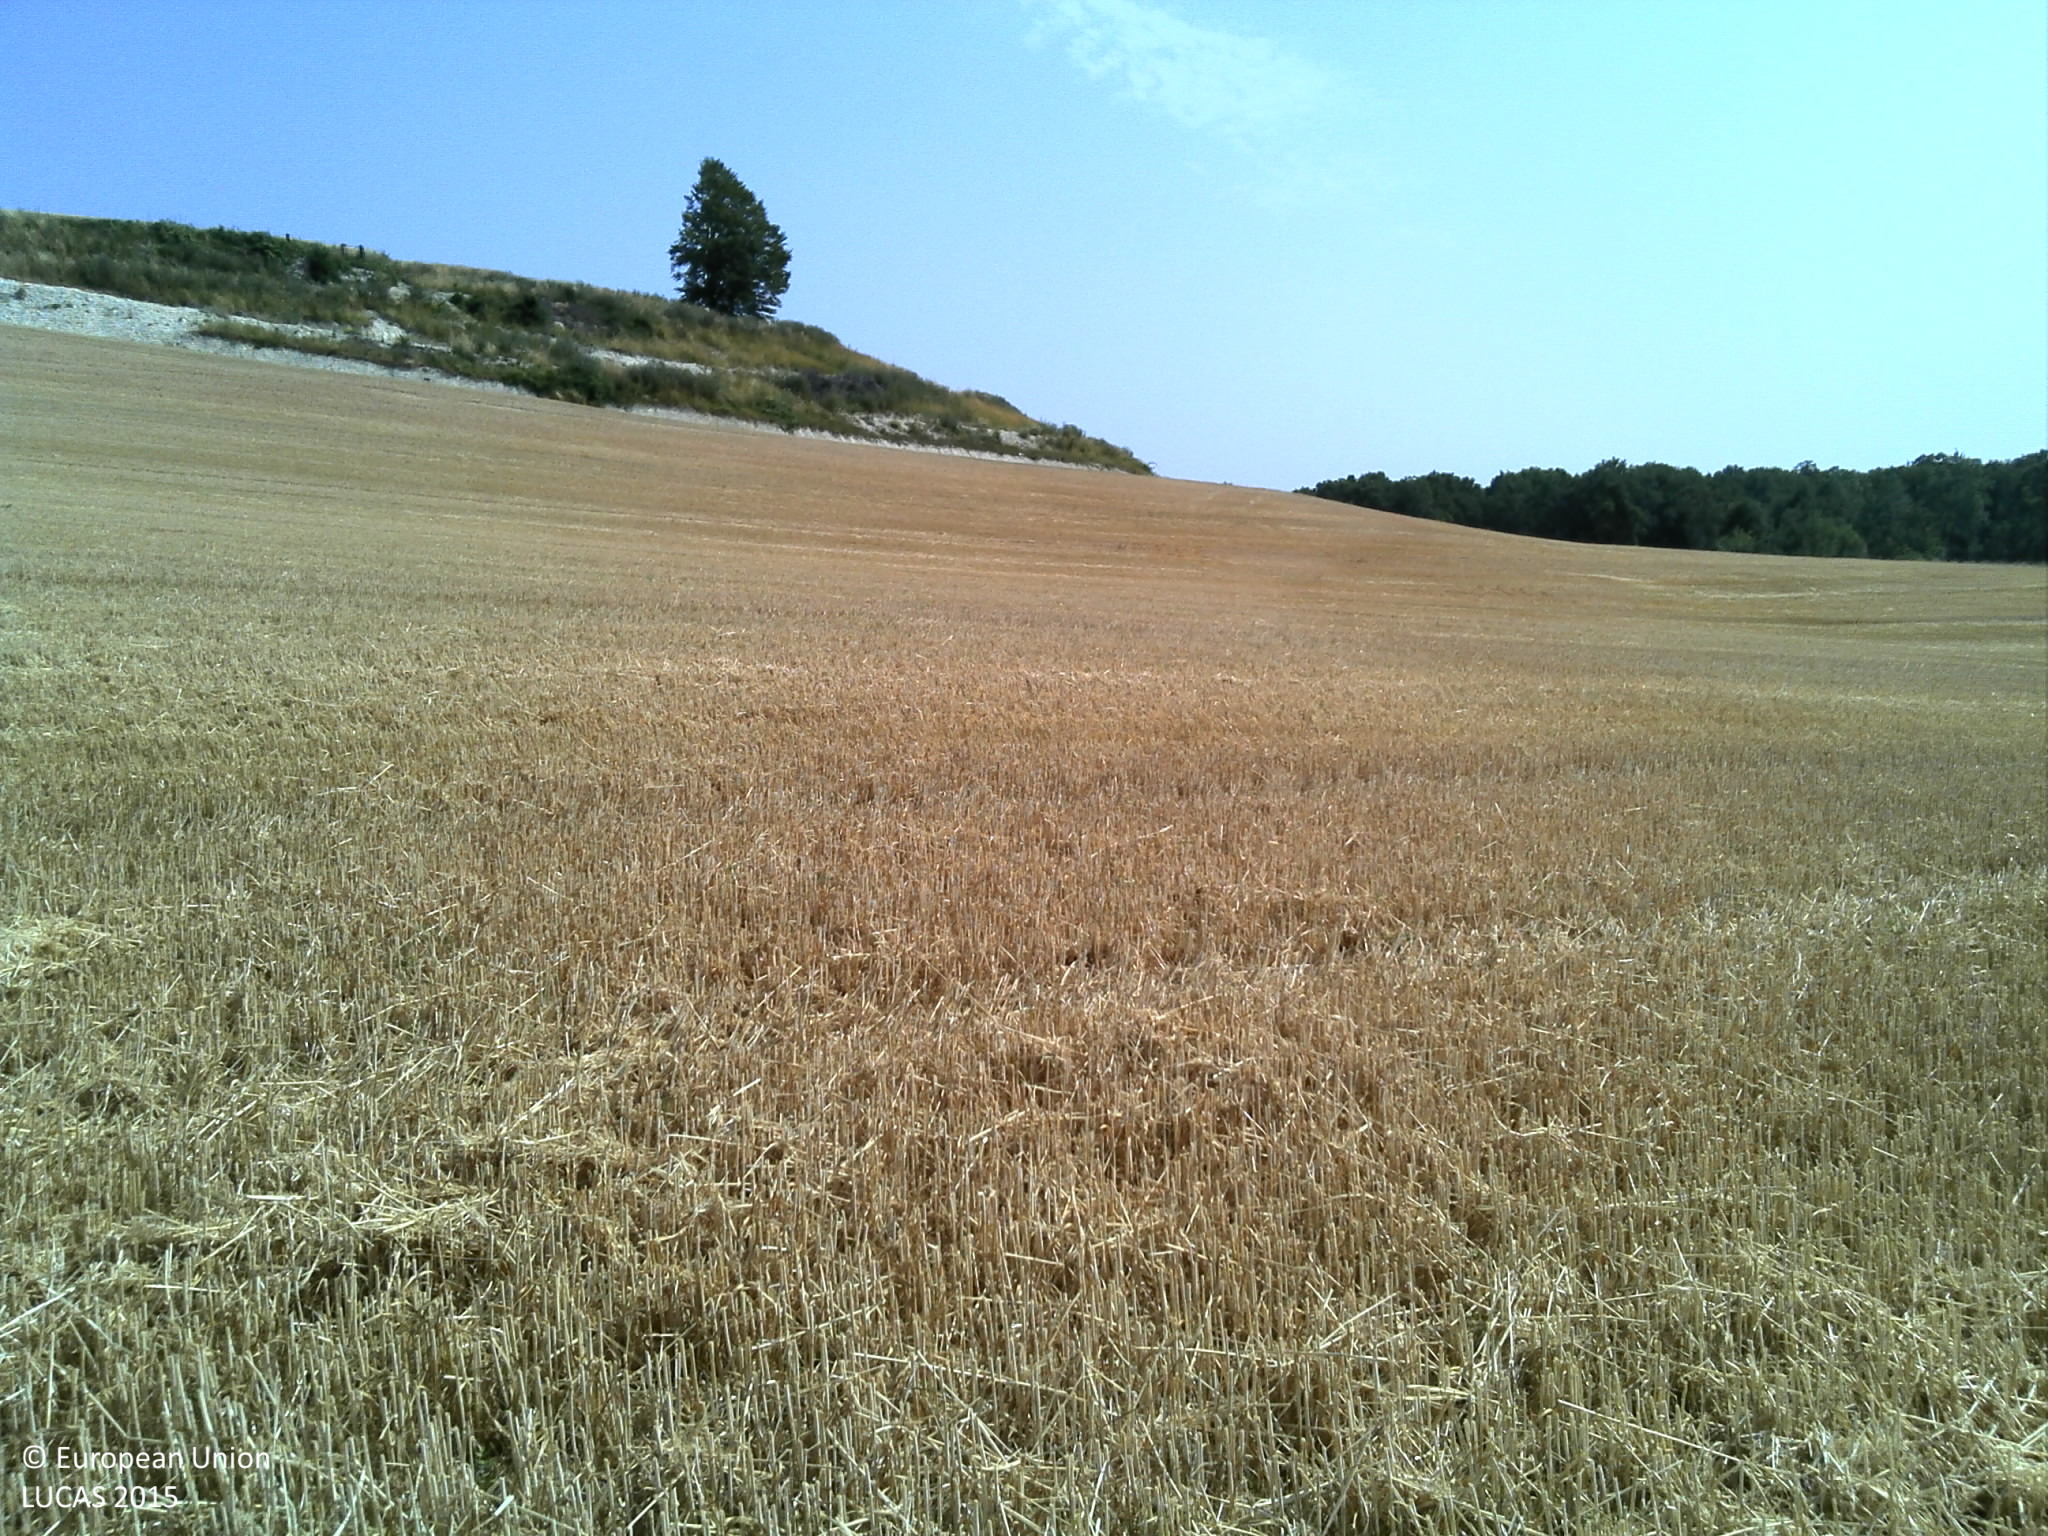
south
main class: Cropland
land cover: Common wheat
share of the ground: > 75 %
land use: Agriculture (excluding fallow land and kitchen gardens)
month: July
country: FR
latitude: 48.8775
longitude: 4.8298
